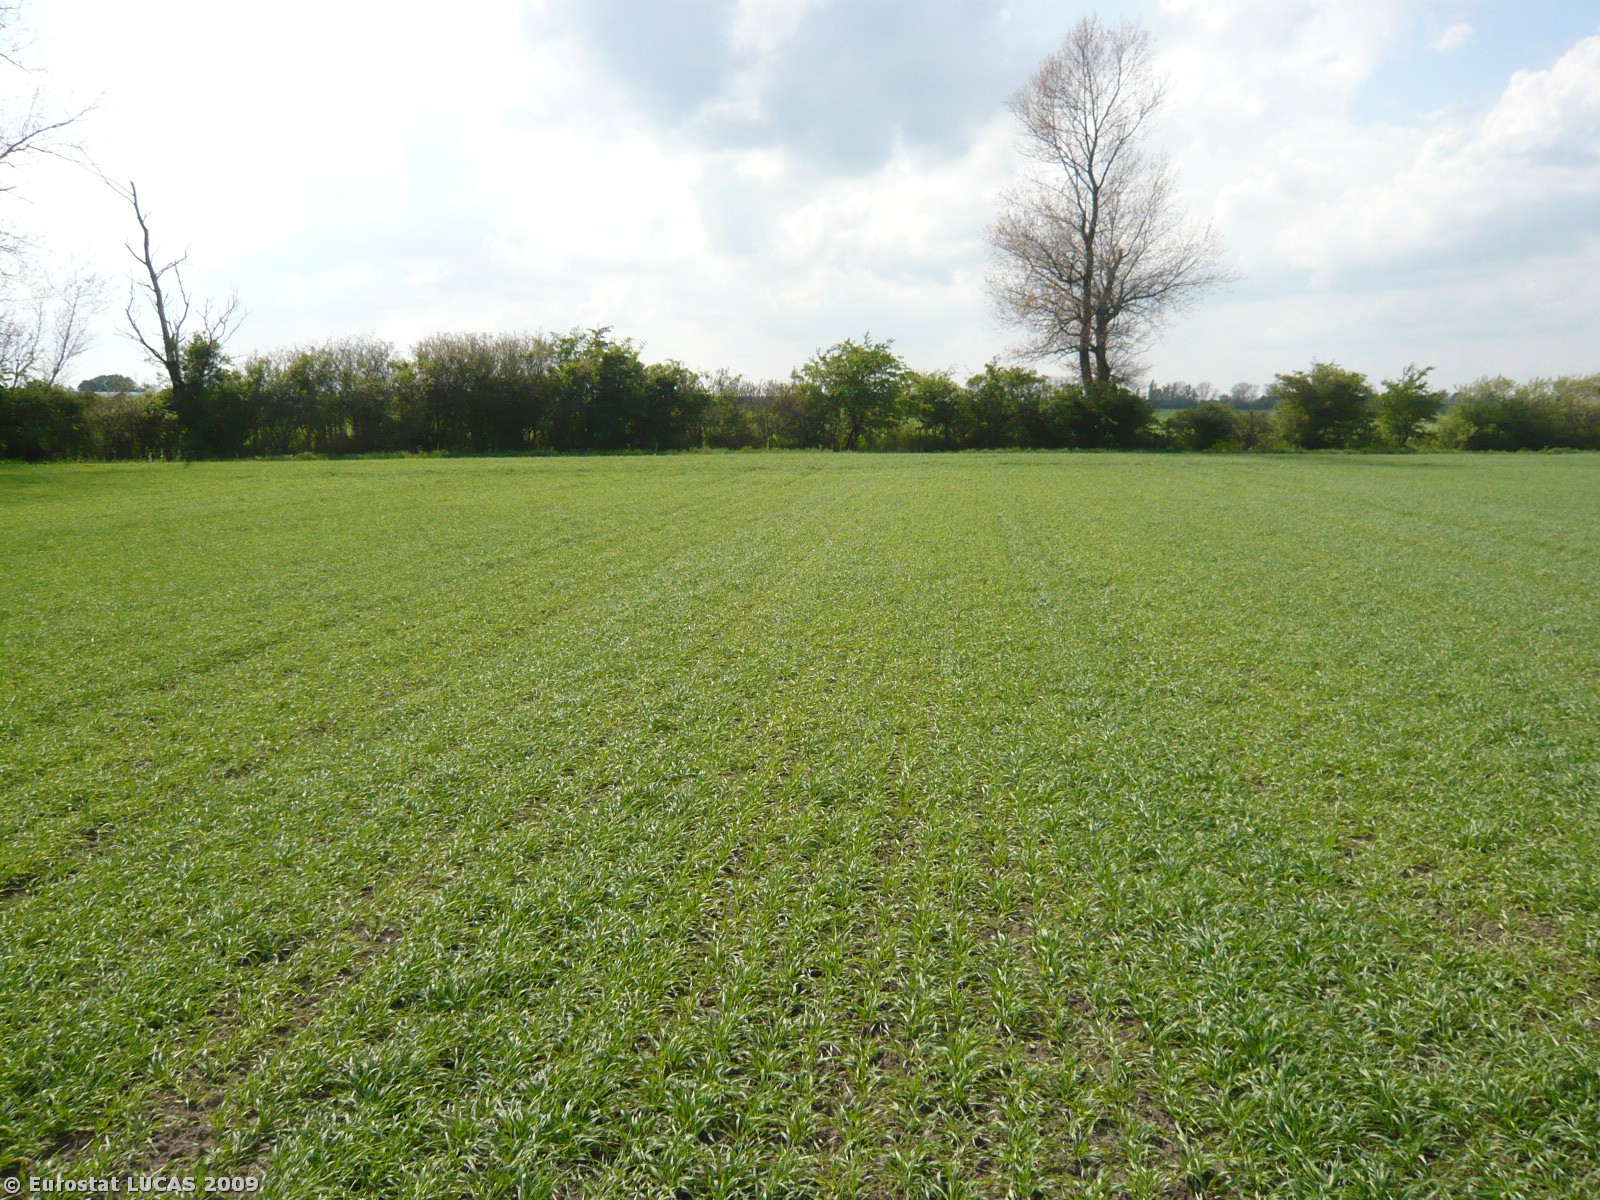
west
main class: Cropland
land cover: Barley
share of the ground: > 75 %
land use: Agriculture (excluding fallow land and kitchen gardens)
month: May
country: DK
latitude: 55.2684
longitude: 12.2805
